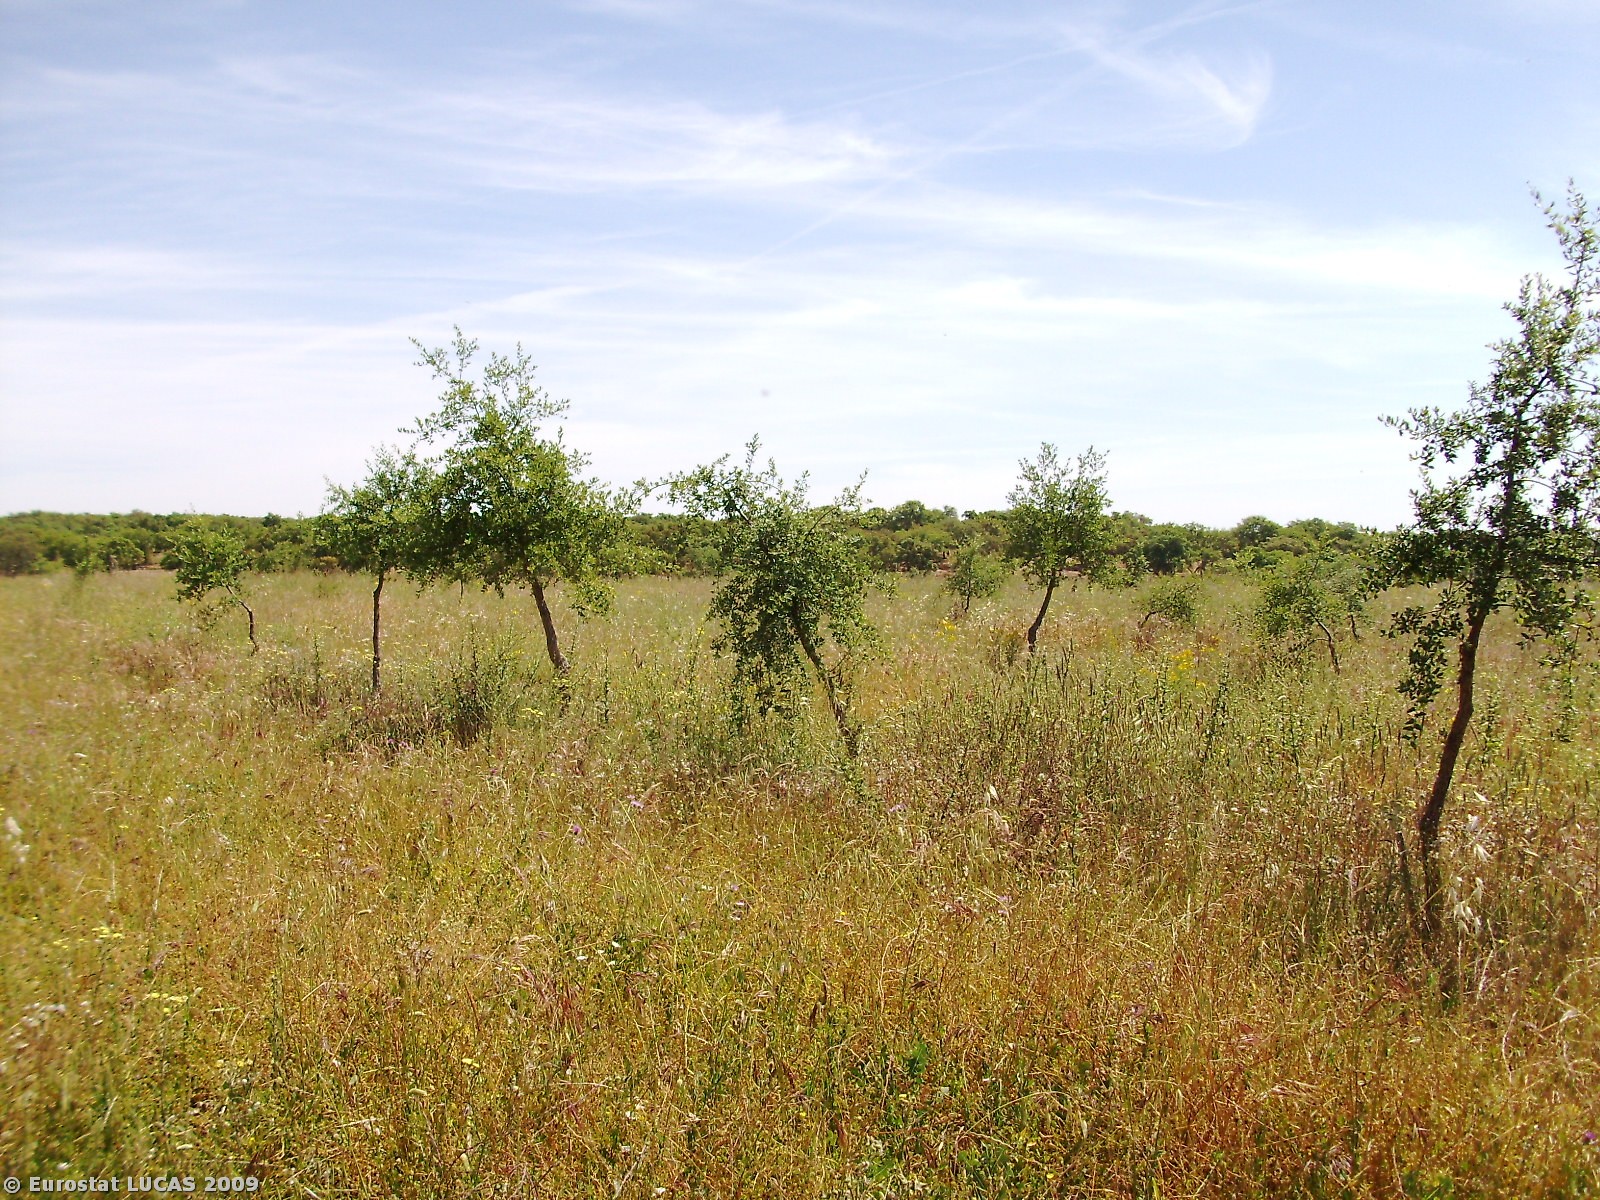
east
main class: Woodland
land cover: Broadleaved woodland
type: broadleaved evergreen forest
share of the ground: 25 - 50 %
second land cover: Spontaneously vegetated surfaces
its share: 50 - 75 %
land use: Forestry
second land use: Fallow land
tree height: > 5 m
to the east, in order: Broadleaved woodland; Spontaneously vegetated surfaces; Broadleaved woodland; Fences; Ditches and canals; Spontaneously vegetated surfaces
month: May
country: PT
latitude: 39.0372
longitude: -8.0629
